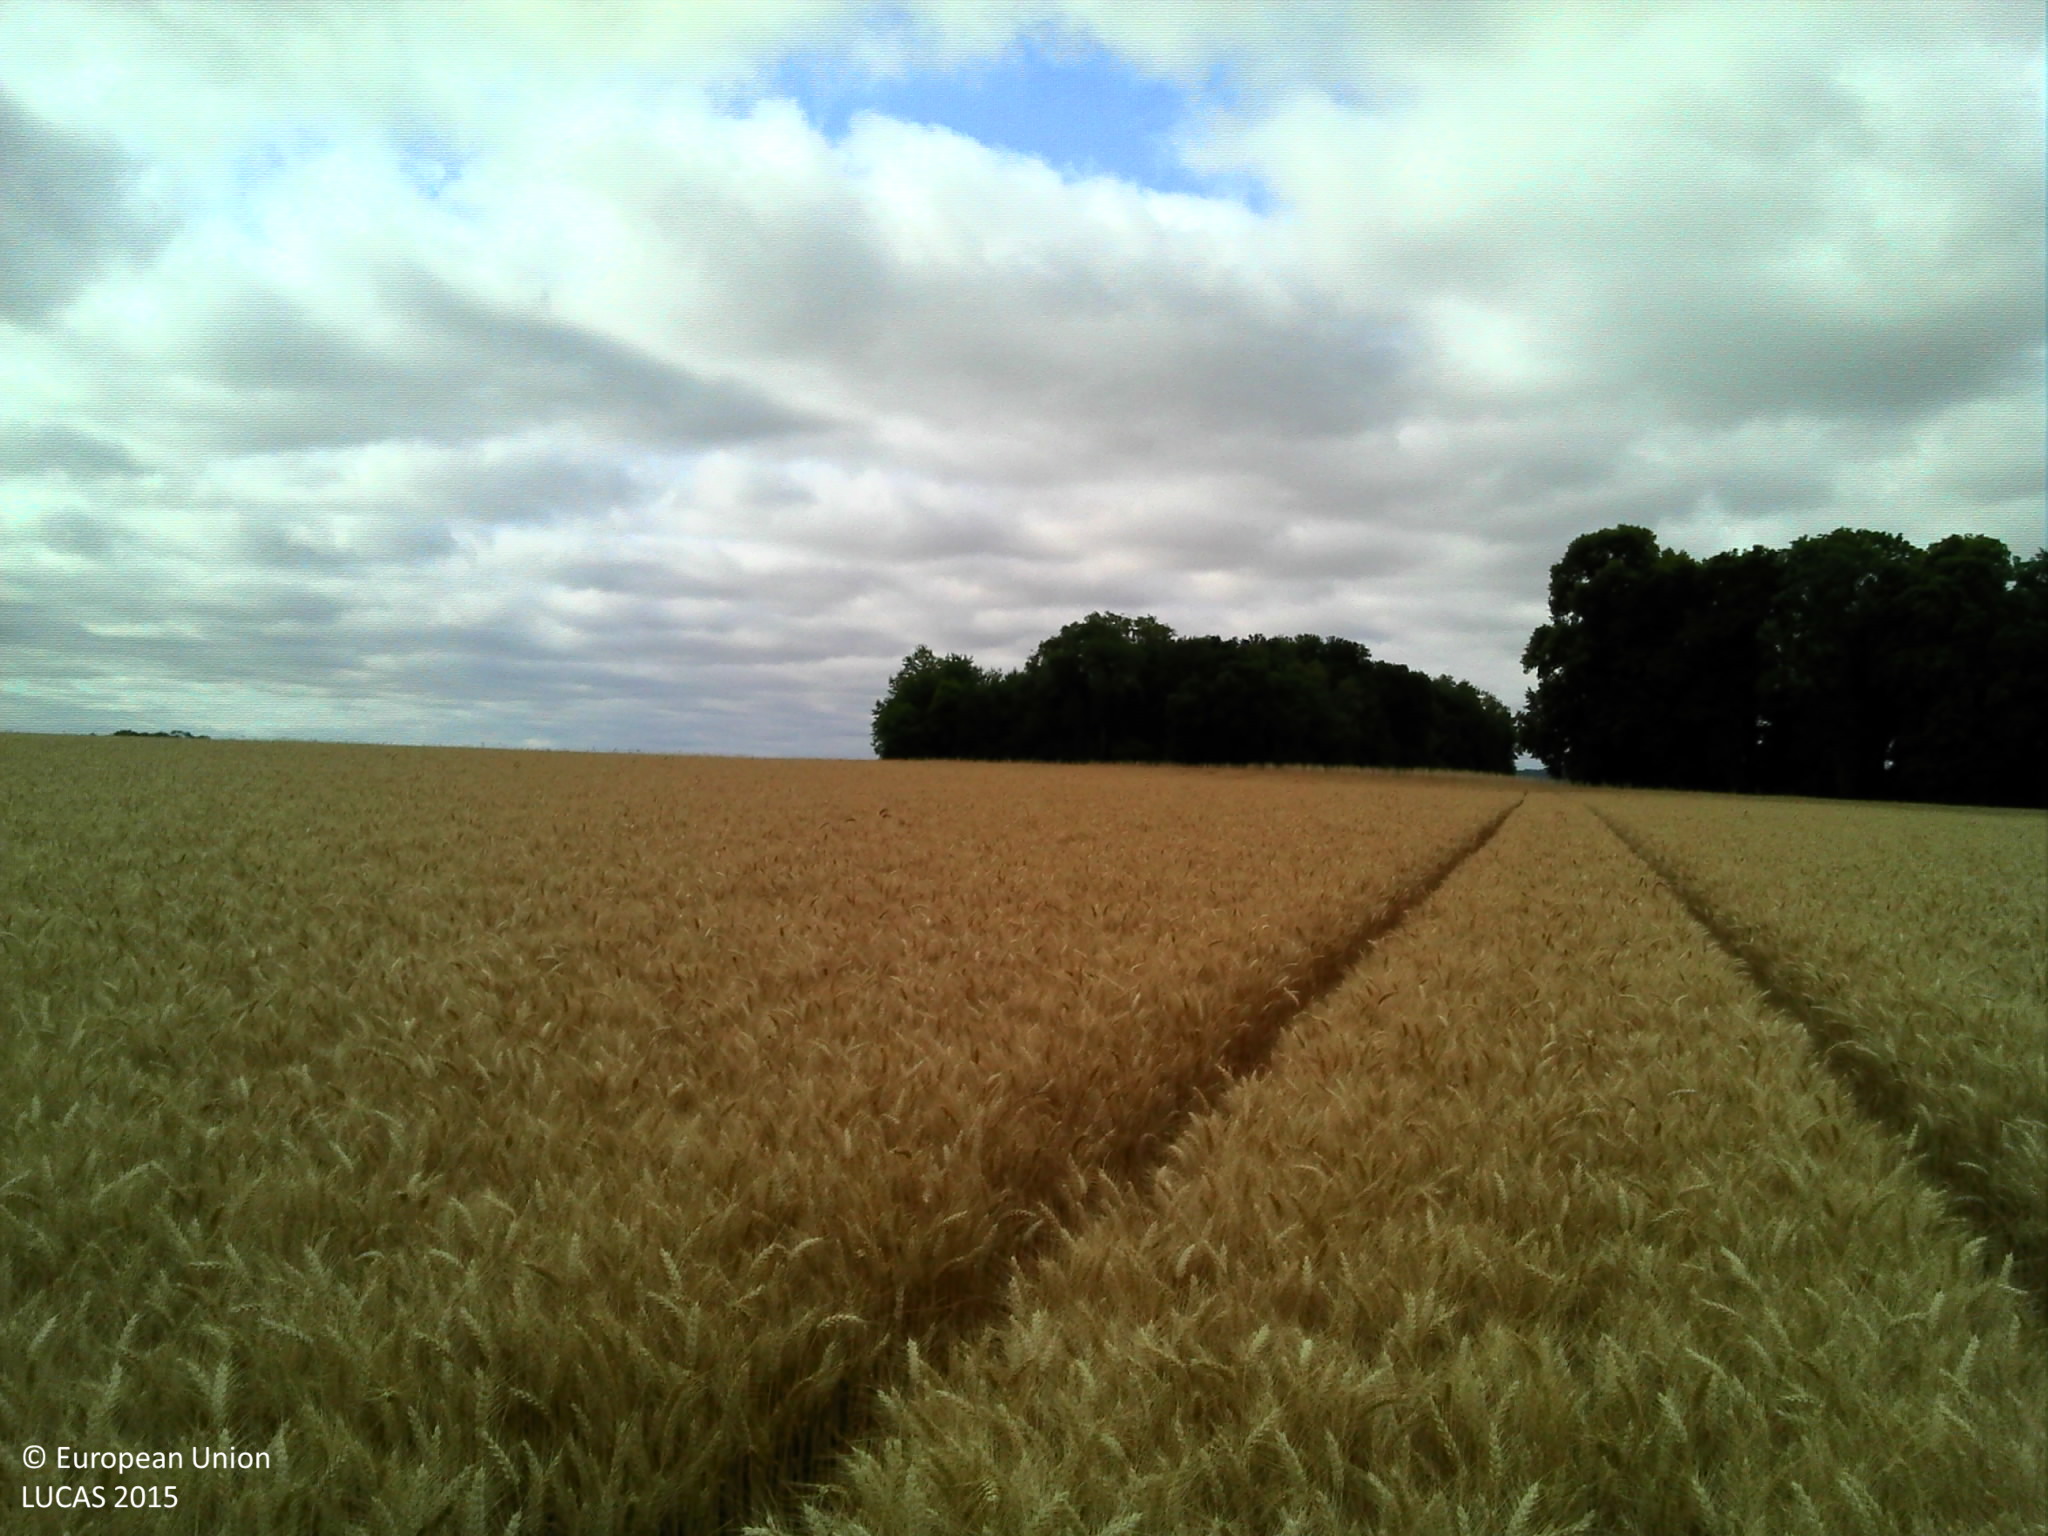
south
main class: Cropland
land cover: Common wheat
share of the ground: > 75 %
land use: Agriculture (excluding fallow land and kitchen gardens)
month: July
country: FR
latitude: 49.3252
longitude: 2.2681
